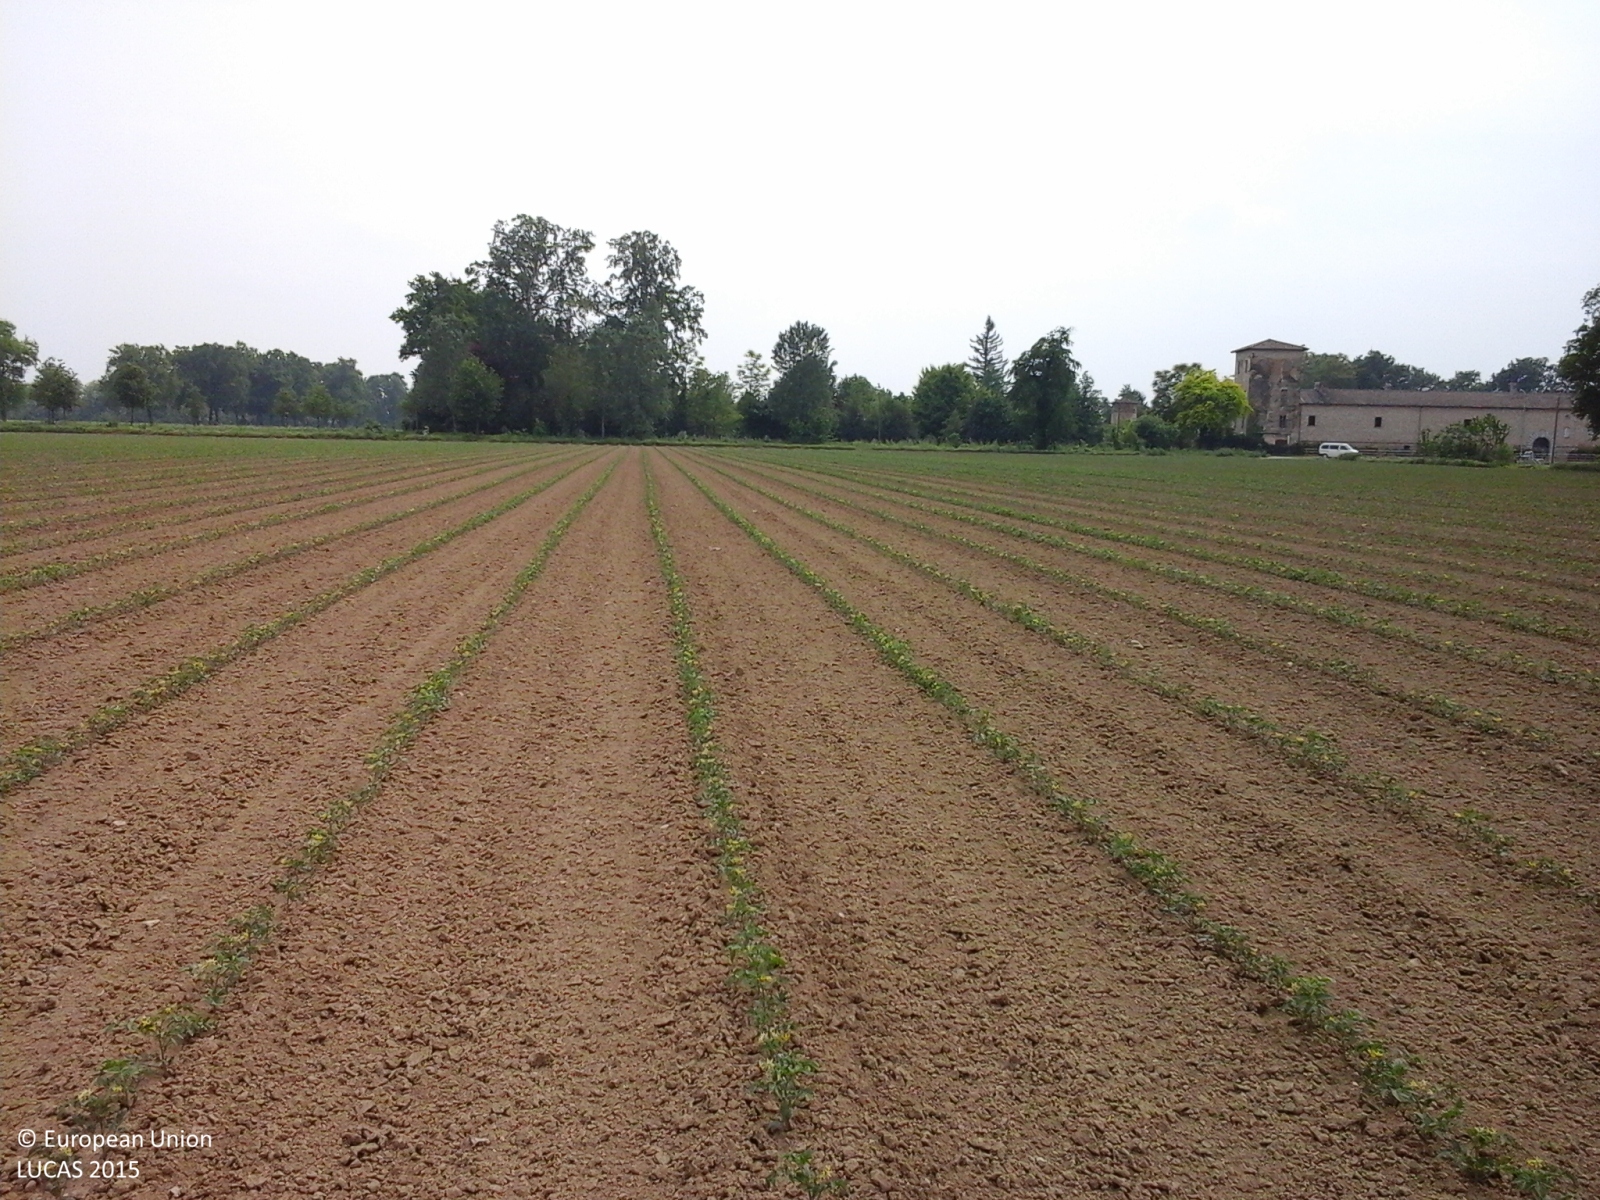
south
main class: Cropland
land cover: Tomatoes
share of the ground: < 10 %
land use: Agriculture (excluding fallow land and kitchen gardens)
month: May
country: IT
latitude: 44.9210
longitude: 8.8241
